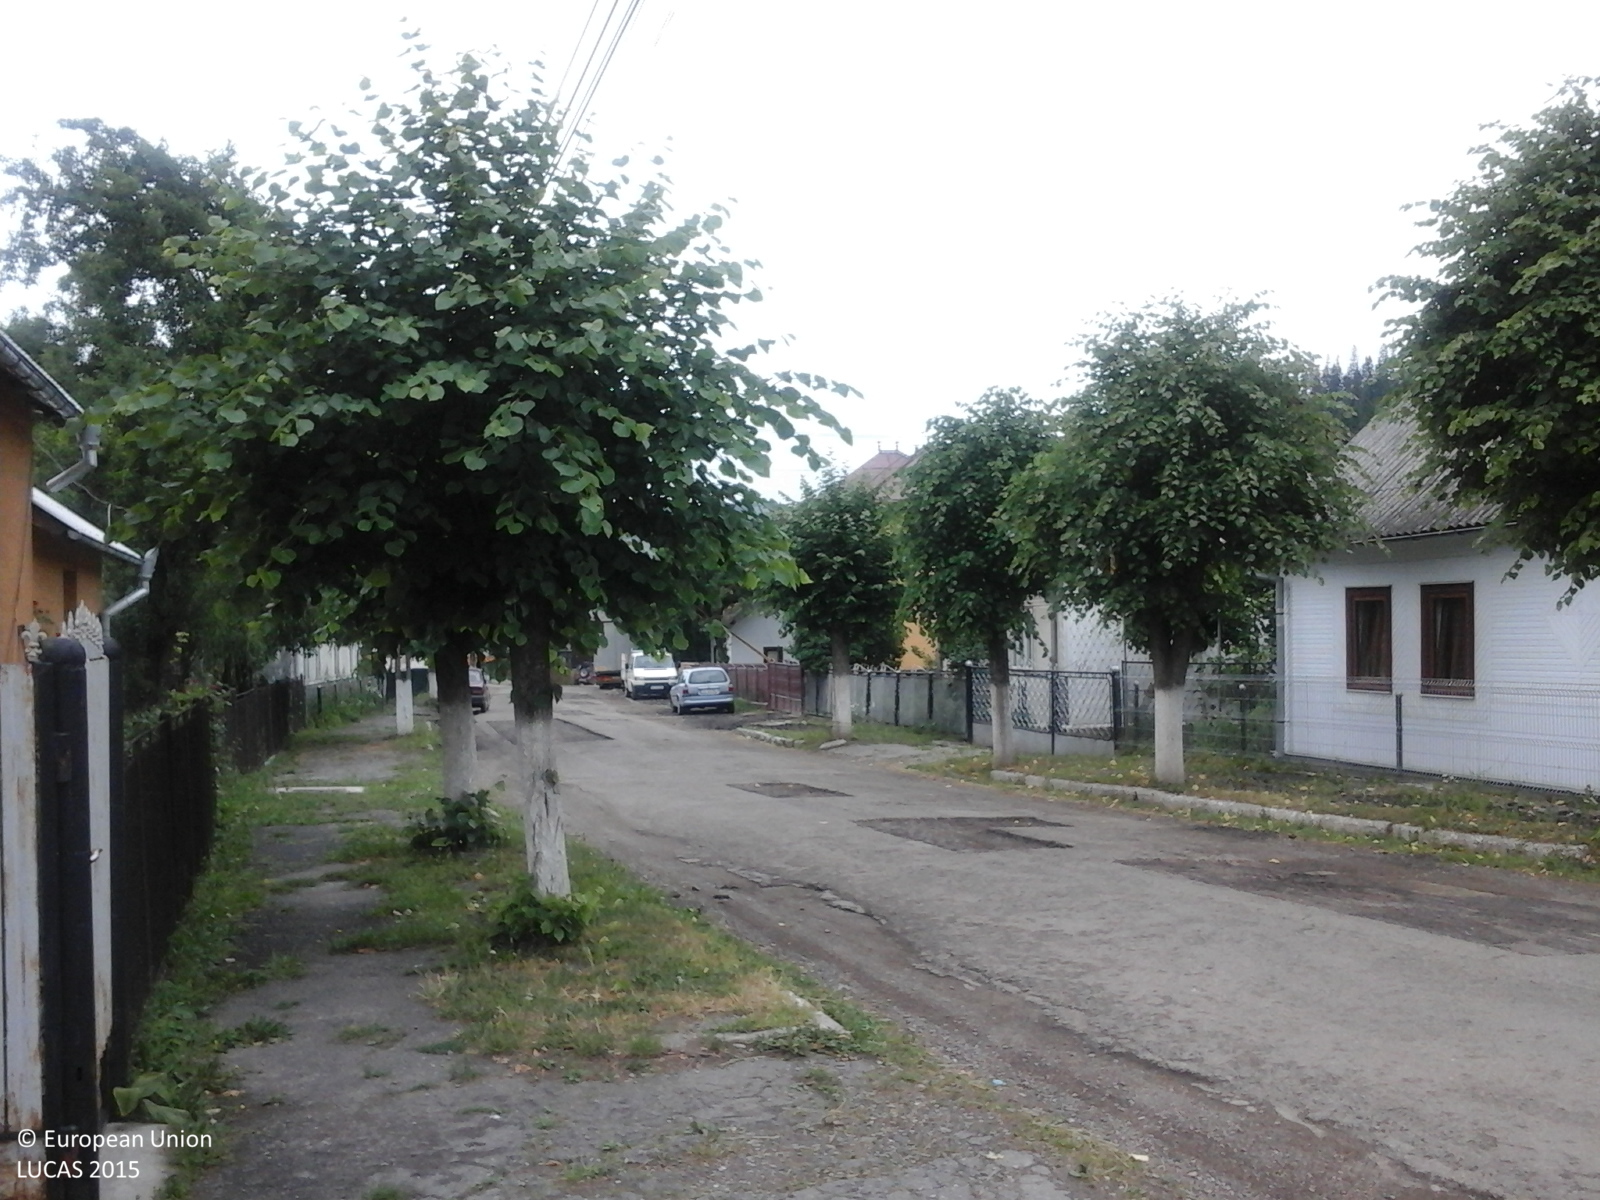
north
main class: Grassland
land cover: Grassland without tree/shrub cover
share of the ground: > 75 %
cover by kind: herbaceous plants 100 %
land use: Agriculture (excluding fallow land and kitchen gardens)
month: June
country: RO
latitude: 47.4650
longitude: 25.7634
